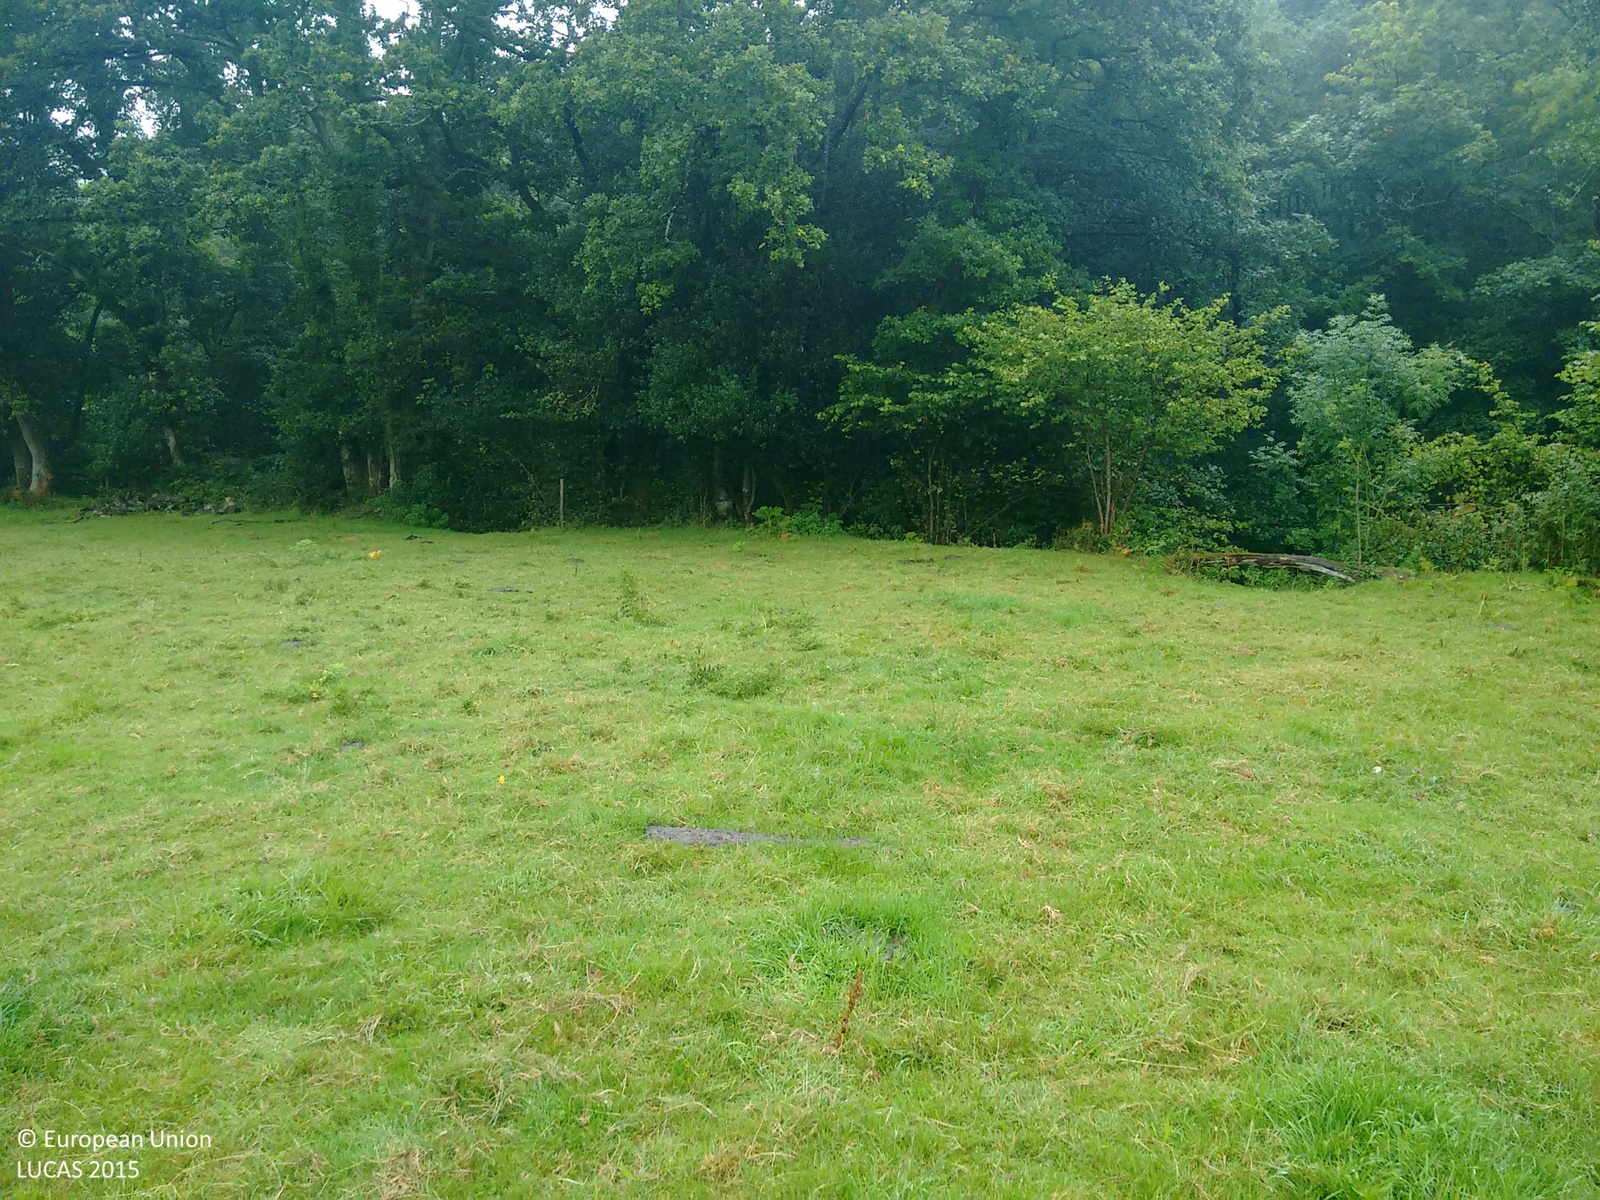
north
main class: Grassland
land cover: Grassland without tree/shrub cover
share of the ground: > 75 %
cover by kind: herbaceous plants 100 %
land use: Agriculture (excluding fallow land and kitchen gardens)
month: August
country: GB
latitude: 50.5185
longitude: -4.1585
